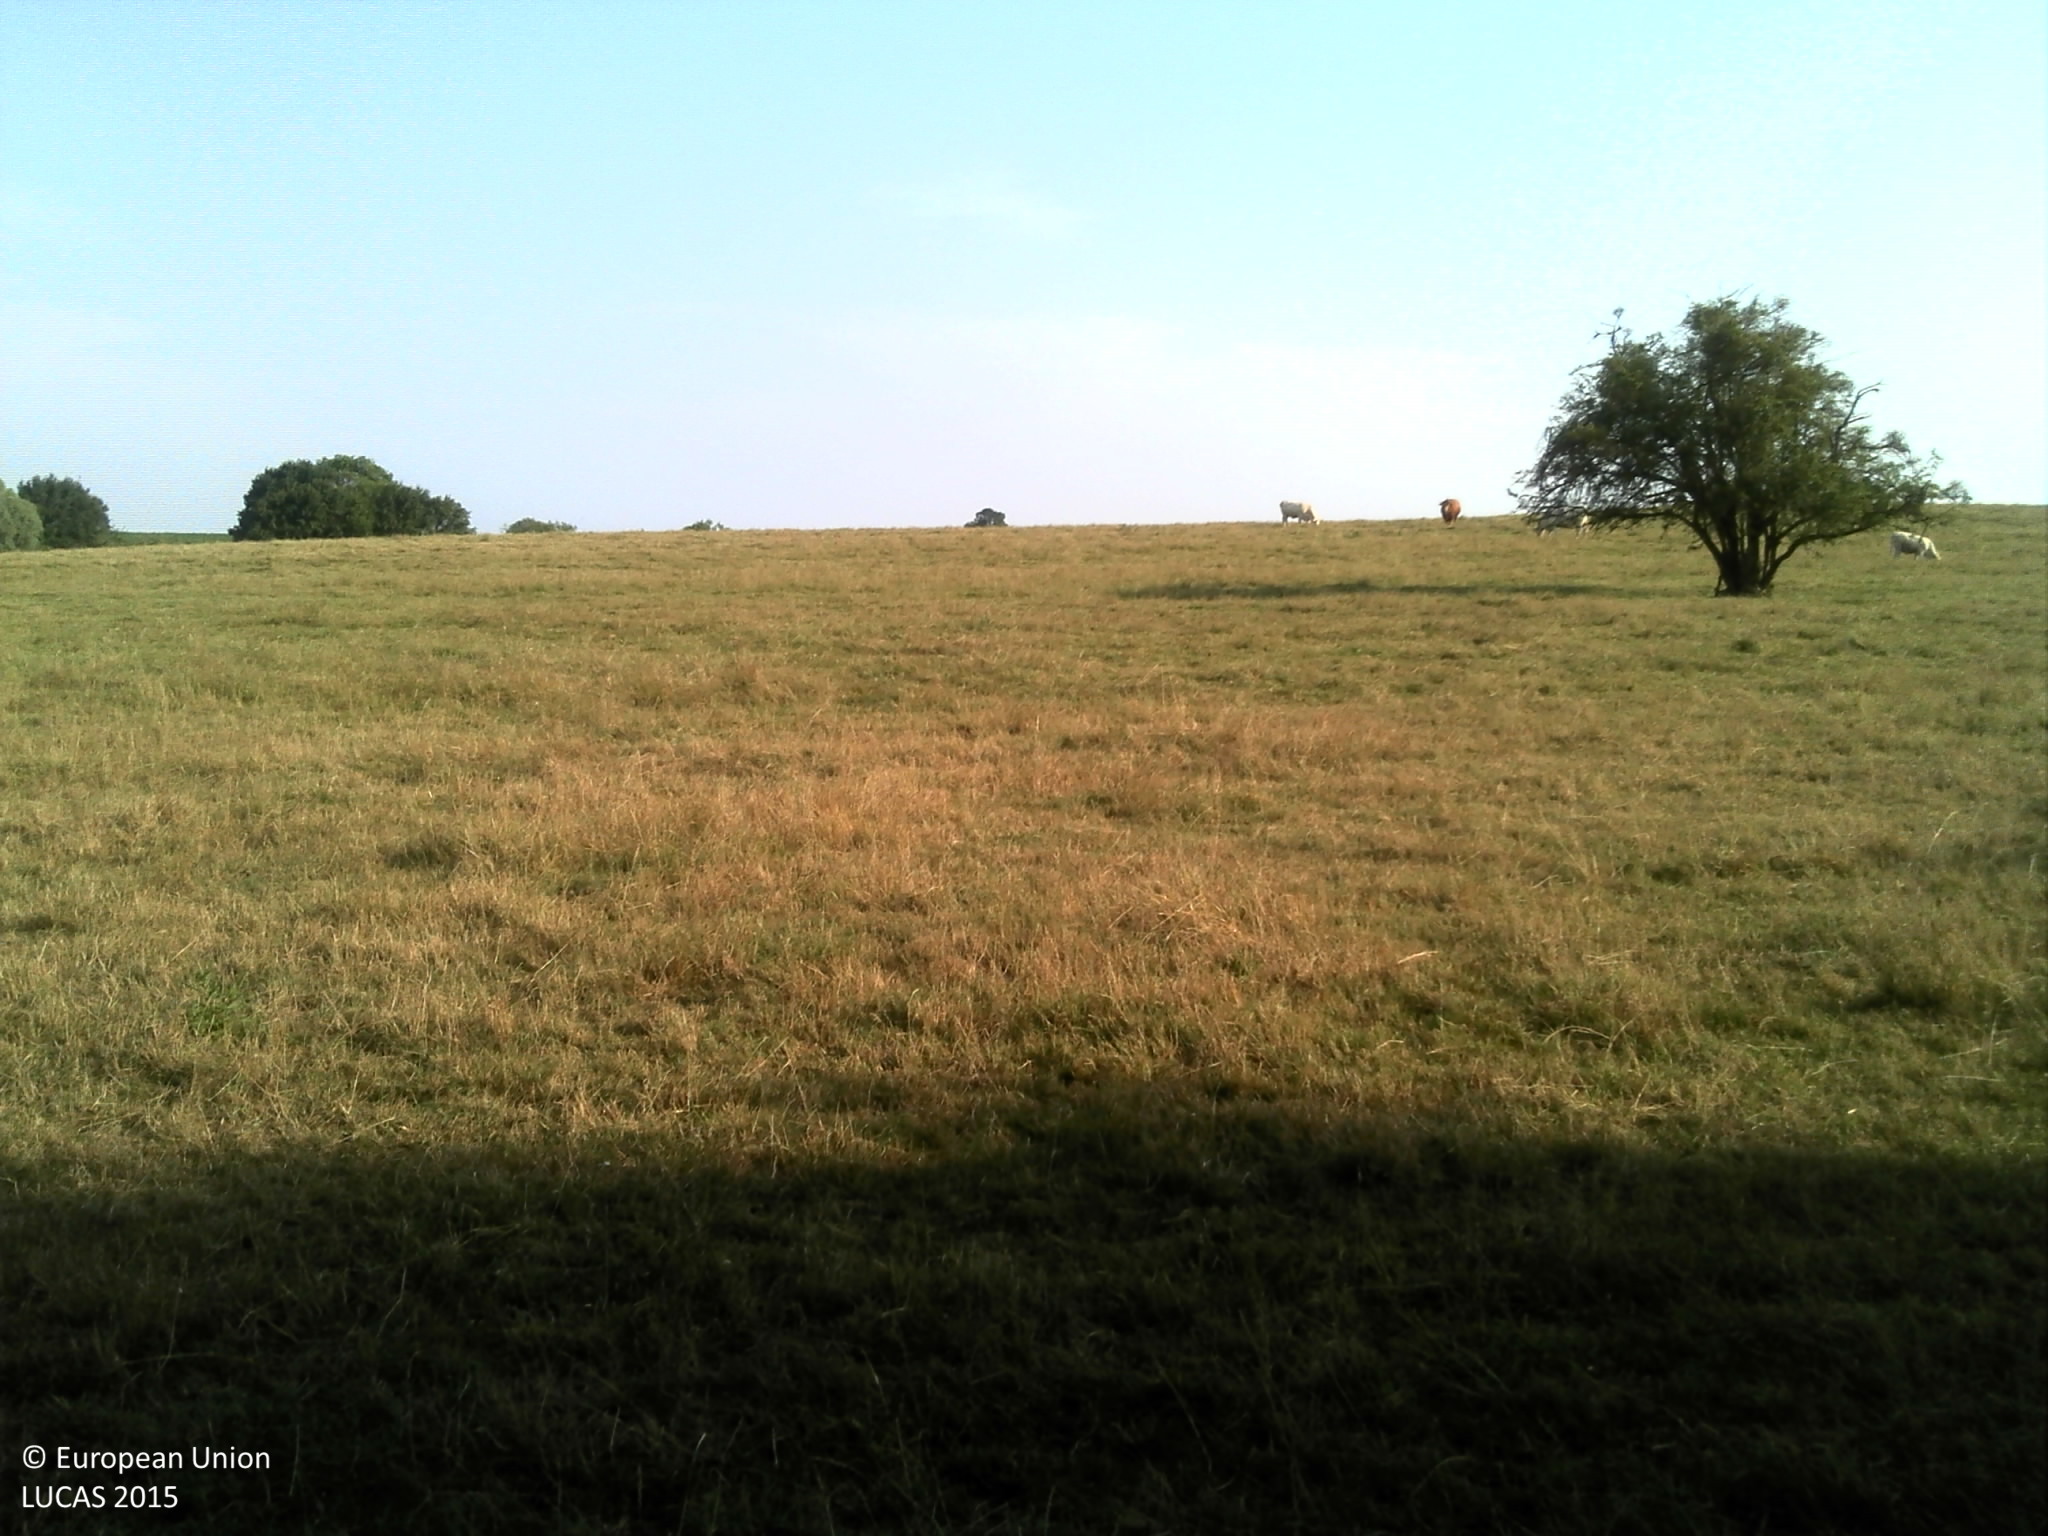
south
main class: Grassland
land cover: Grassland with sparse tree/shrub cover
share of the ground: > 75 %
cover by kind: herbaceous plants 95 %, broadleaved forest trees 5 %
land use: Agriculture (excluding fallow land and kitchen gardens)
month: July
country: FR
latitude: 48.8613
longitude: 6.7971
